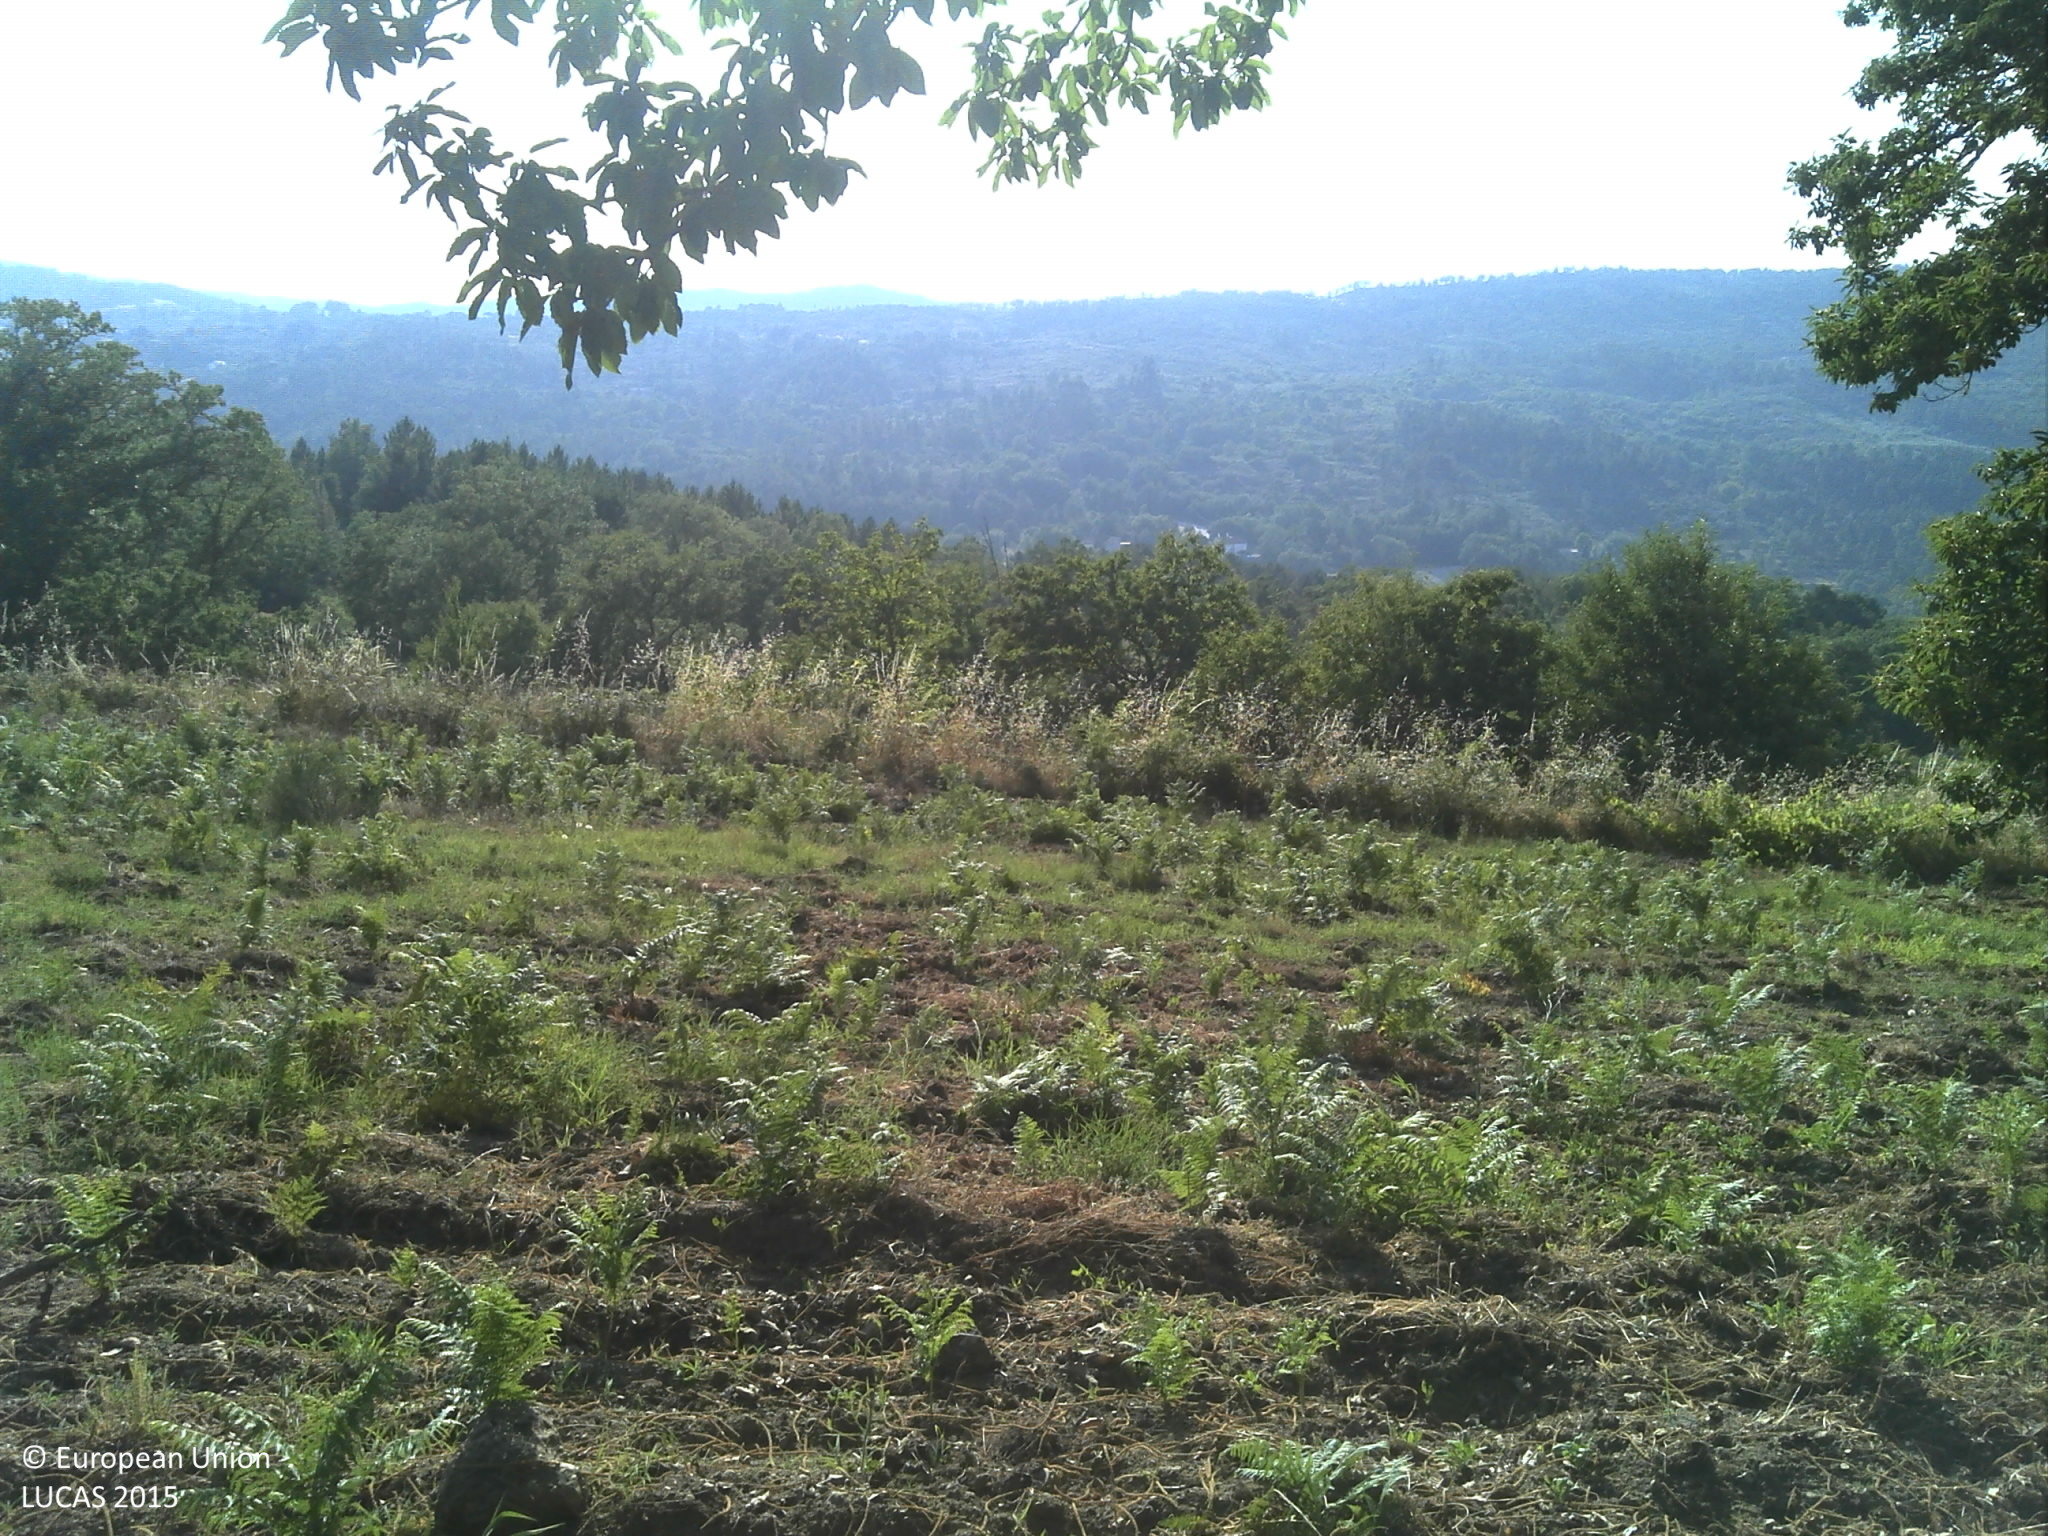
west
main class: Cropland
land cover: Nuts trees
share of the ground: 25 - 50 %
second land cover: Spontaneously vegetated surfaces
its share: 10 - 25 %
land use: Agriculture (excluding fallow land and kitchen gardens)
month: July
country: PT
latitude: 40.8939
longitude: -7.5065
